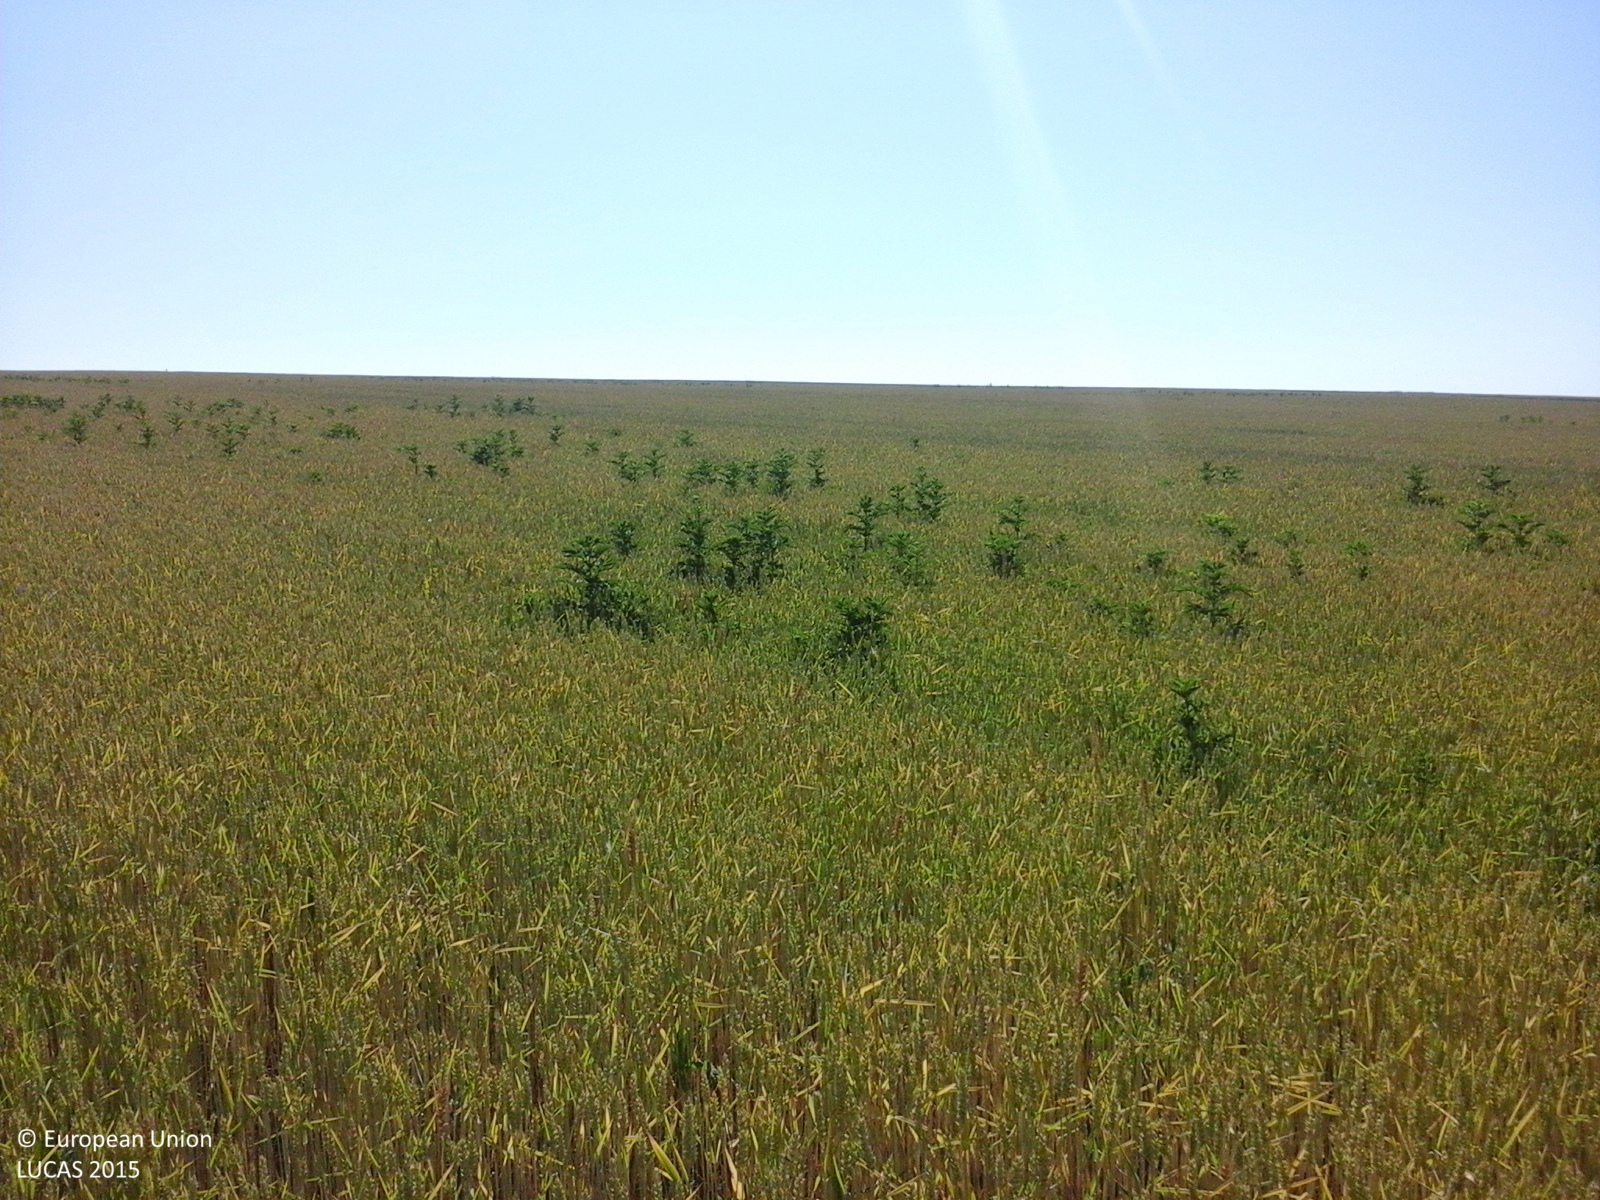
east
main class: Cropland
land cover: Common wheat
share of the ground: > 75 %
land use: Agriculture (excluding fallow land and kitchen gardens)
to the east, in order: Common wheat
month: June
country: RO
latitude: 47.6804
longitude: 27.1185
